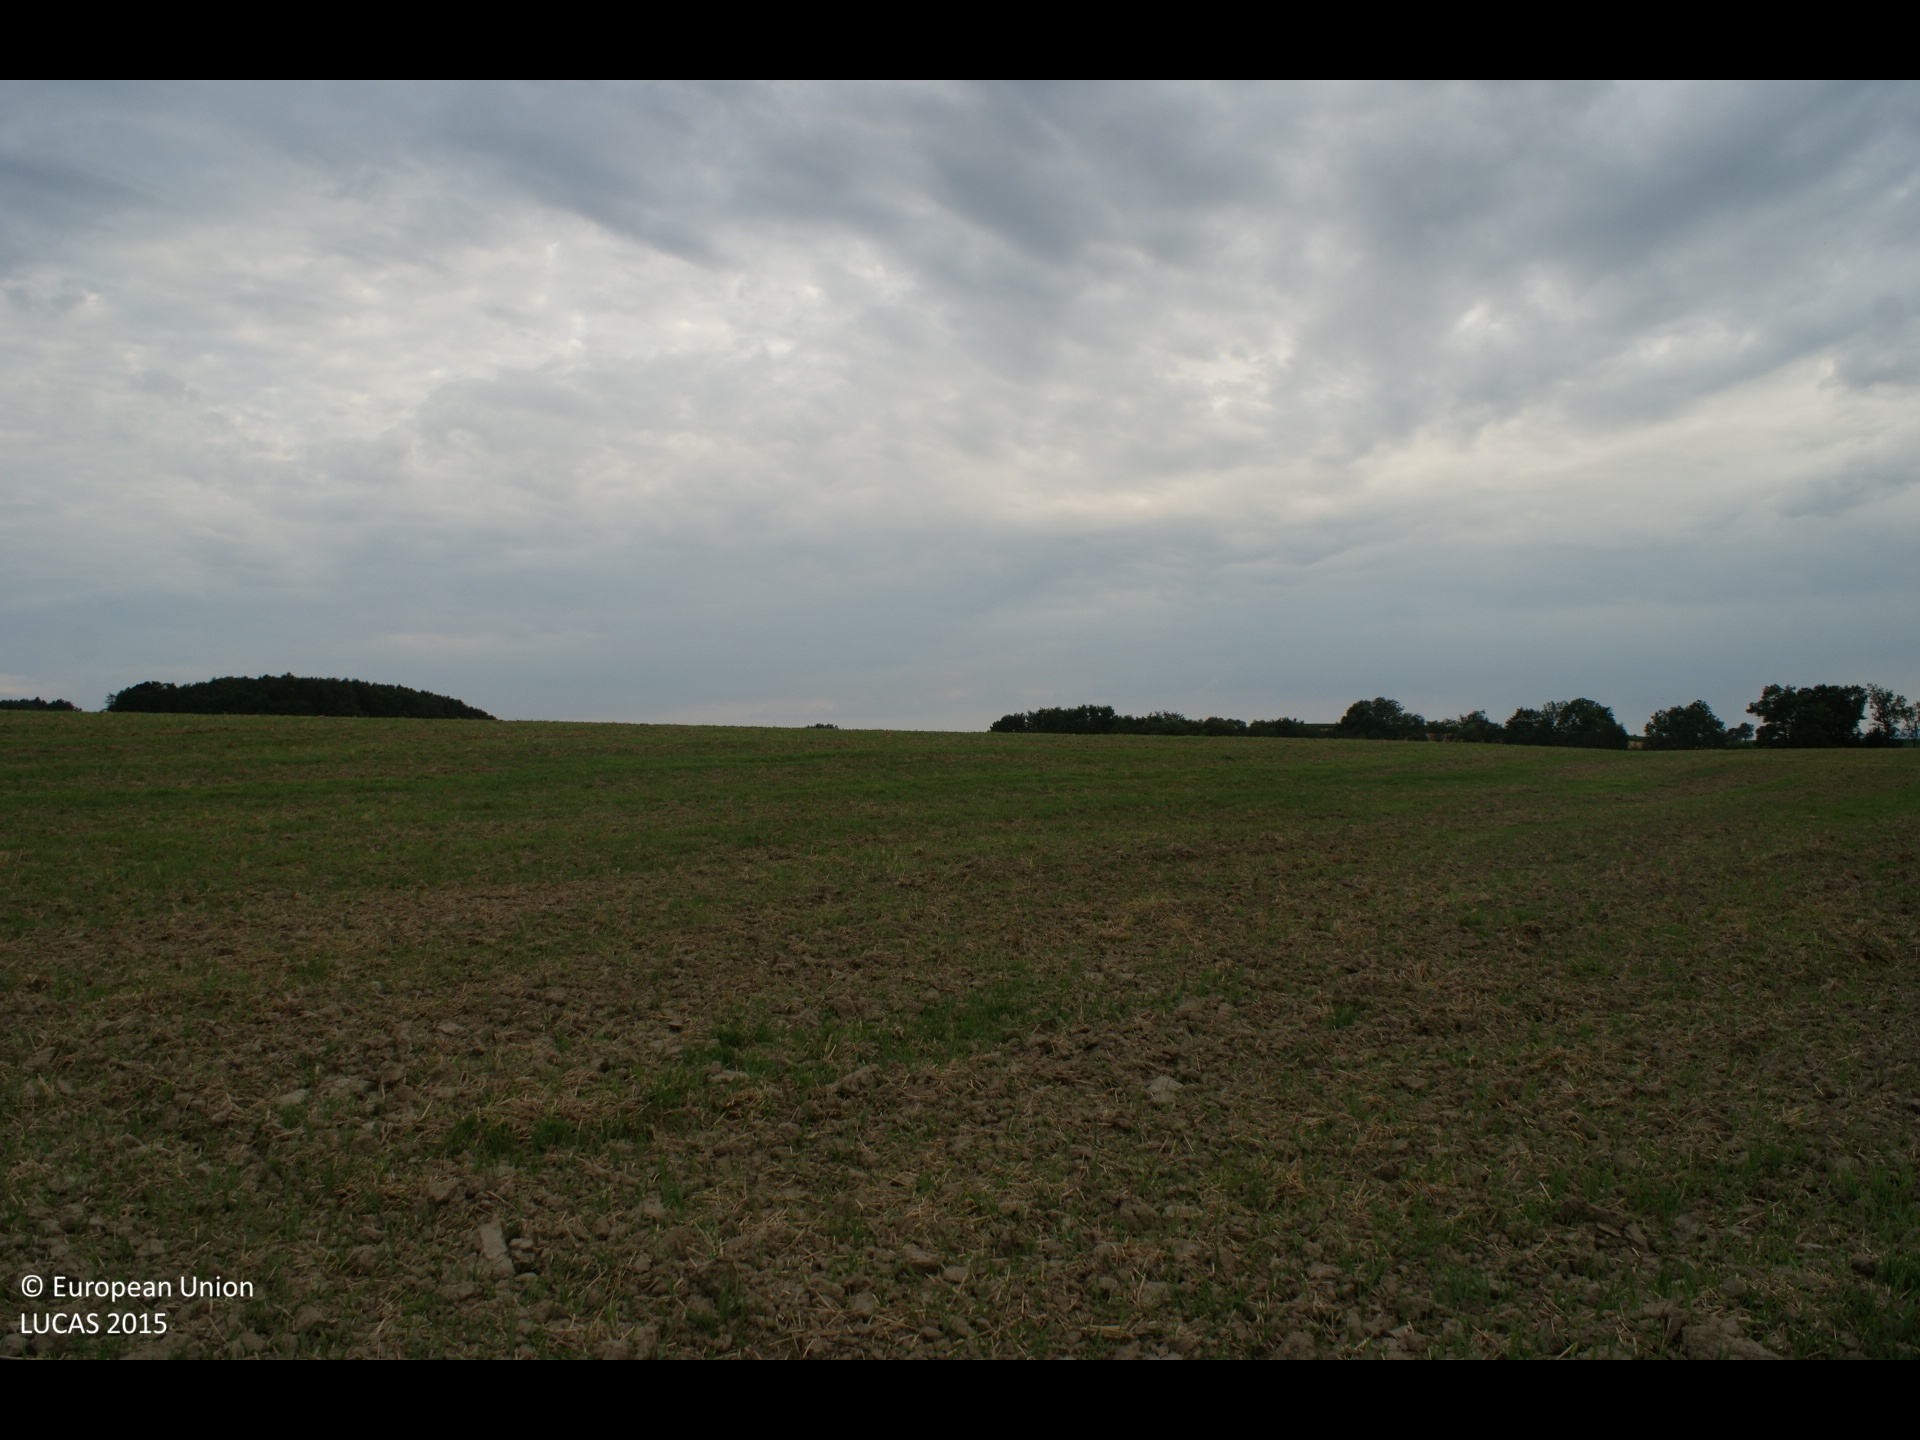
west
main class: Cropland
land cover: Temporary grasslands
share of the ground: 10 - 25 %
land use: Agriculture (excluding fallow land and kitchen gardens)
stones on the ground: < 10 %
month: July
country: AT
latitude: 48.0932
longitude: 15.3590
